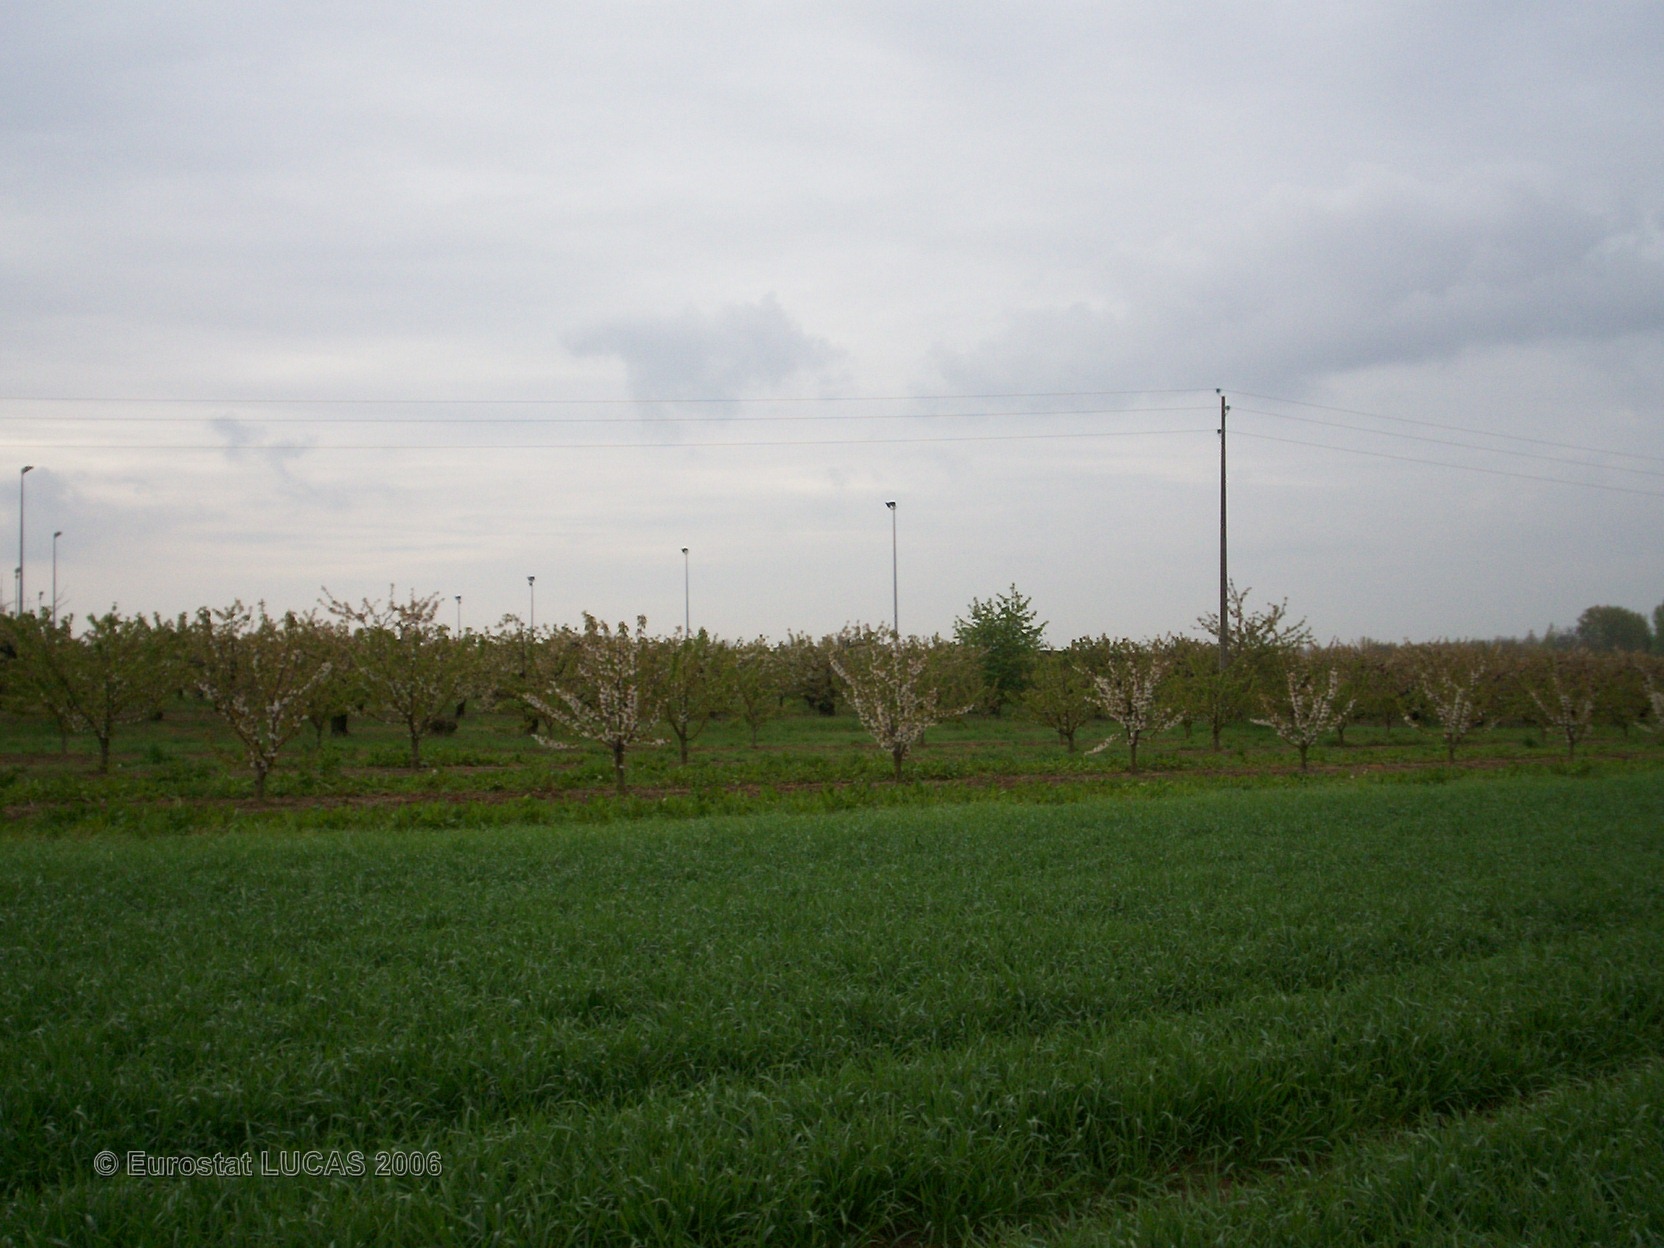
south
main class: Cropland
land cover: Common wheat
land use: Agriculture (excluding fallow land and kitchen gardens)
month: April
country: FR
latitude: 44.1009
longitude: 0.9656
